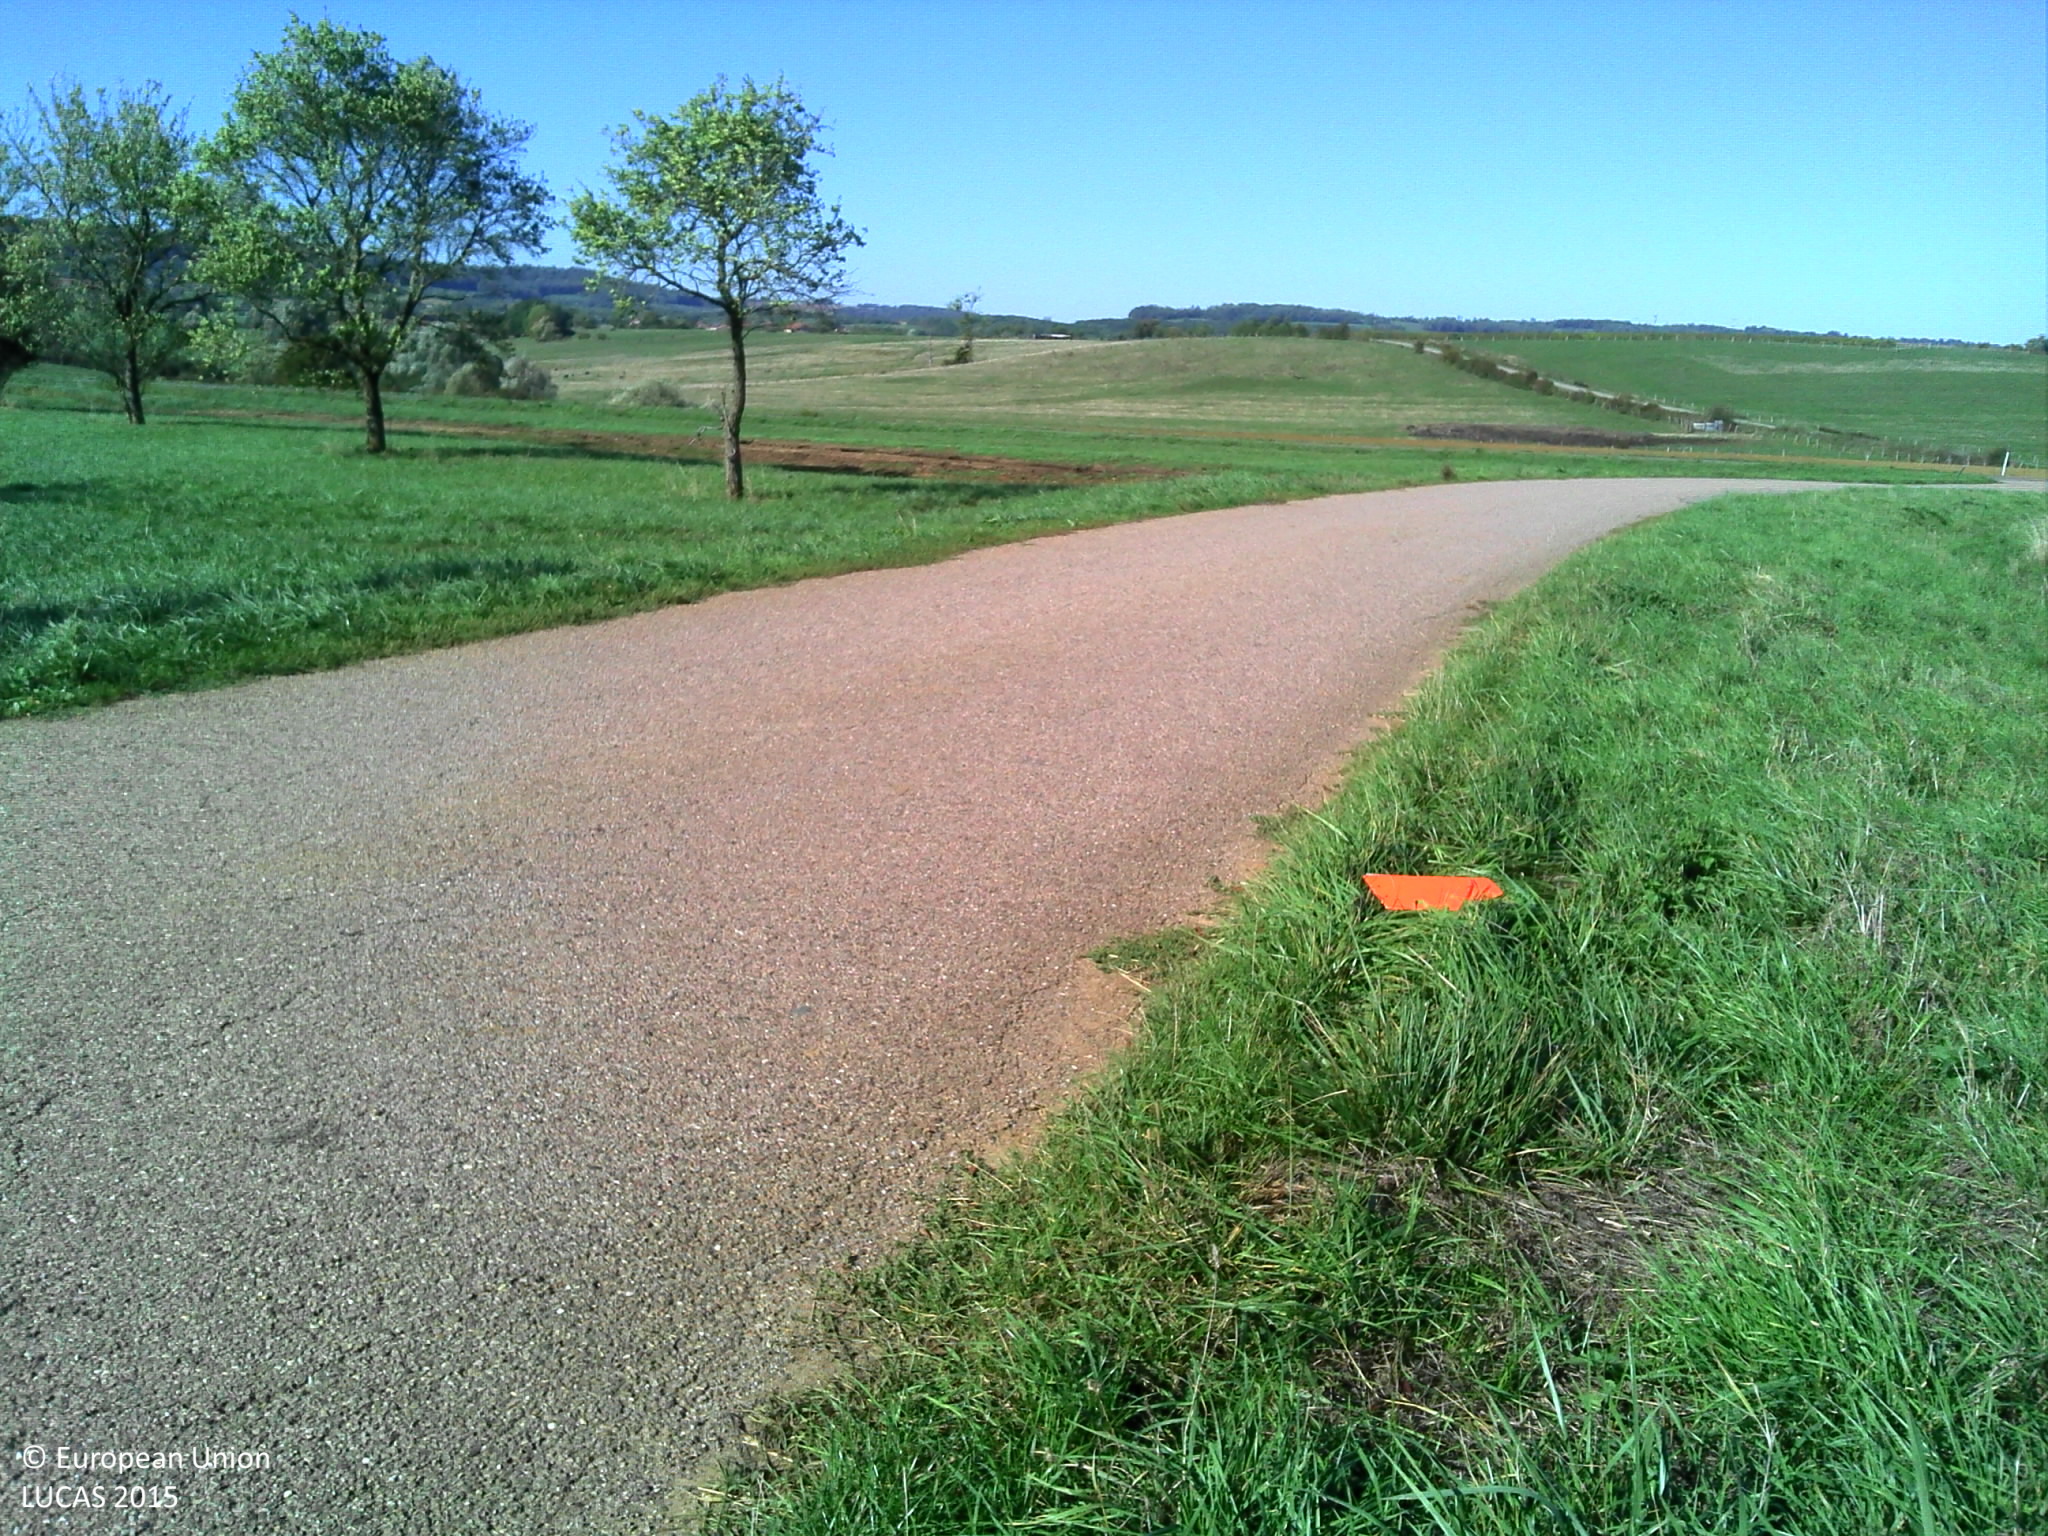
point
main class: Grassland
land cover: Grassland without tree/shrub cover
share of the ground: > 75 %
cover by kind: herbaceous plants 80 %, consolidated bare surface 20 %
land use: Road transport
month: September
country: FR
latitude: 48.4586
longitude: 6.0379
